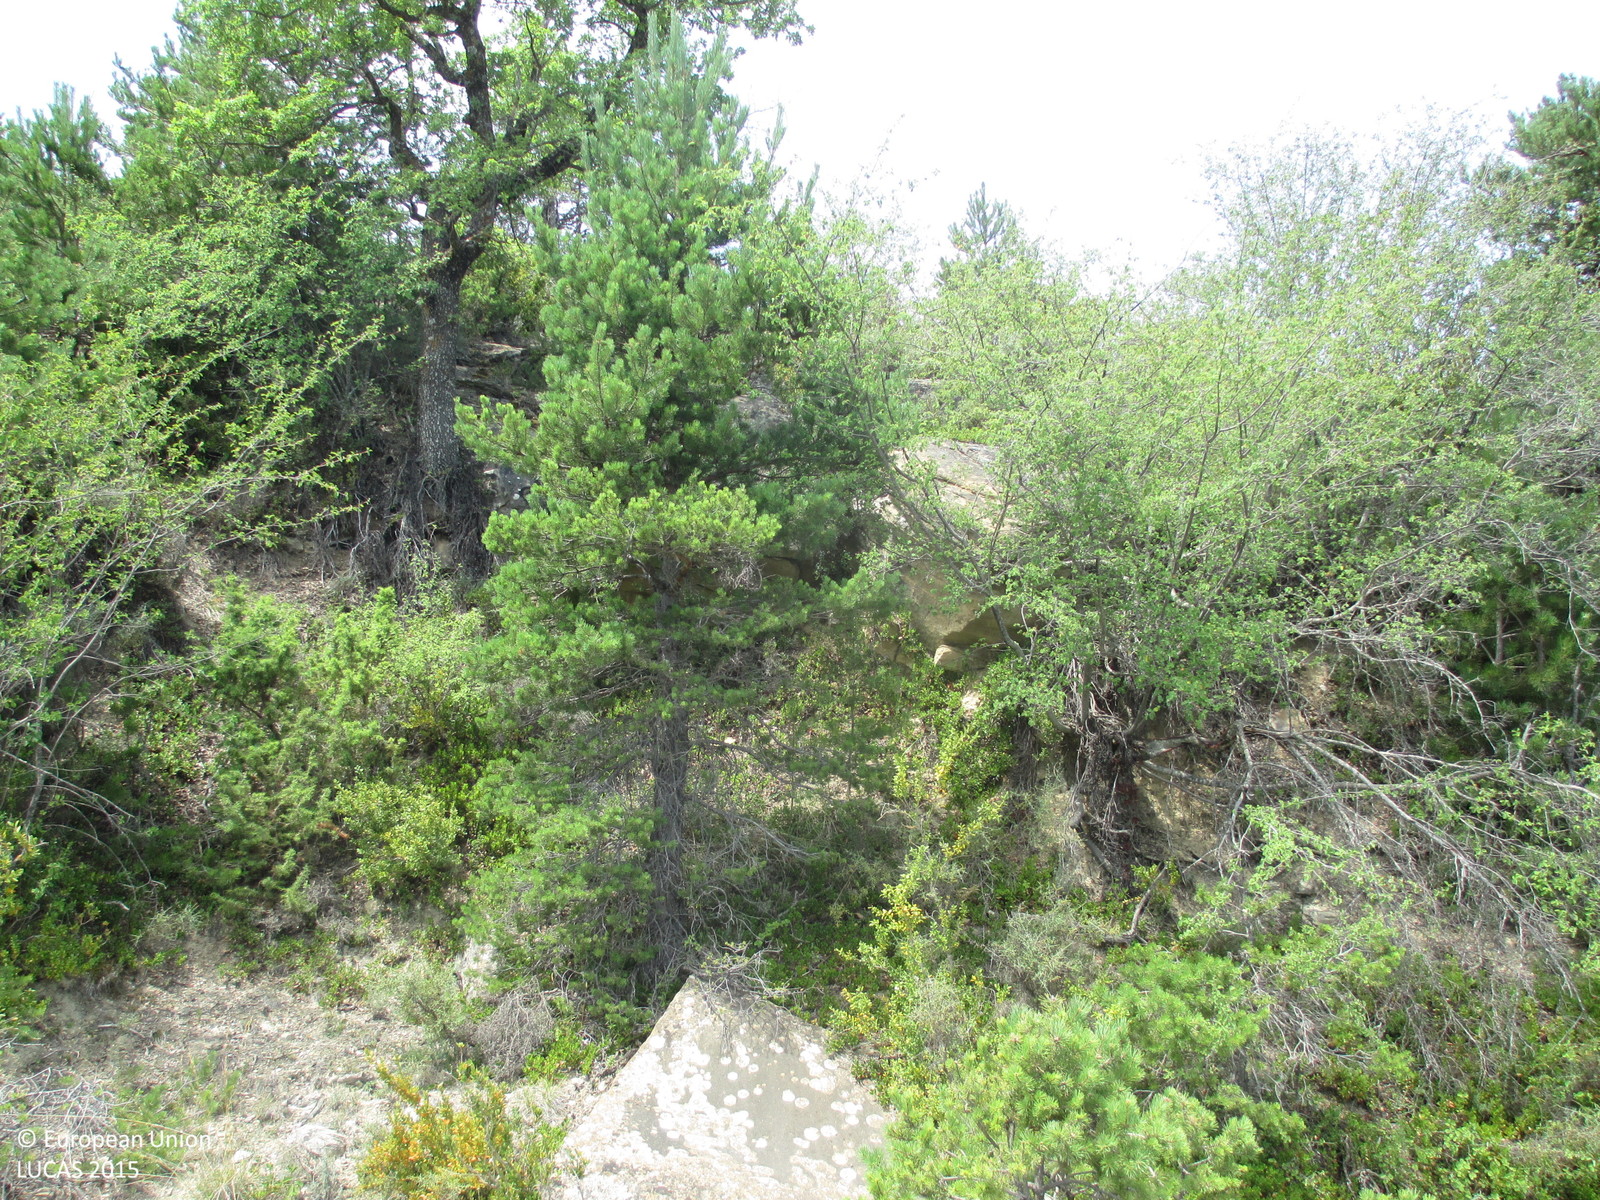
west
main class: Shrubland
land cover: Shrubland with sparse tree cover
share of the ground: > 75 %
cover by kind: shrubs 70 %, herbaceous plants 10 %, unconsolidated bare surface 10 %, coniferous forest trees 5 %, consolidated bare surface 5 %
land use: Semi-natural and natural areas not in use
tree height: > 5 m
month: July
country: ES
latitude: 42.3915
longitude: -0.3863
